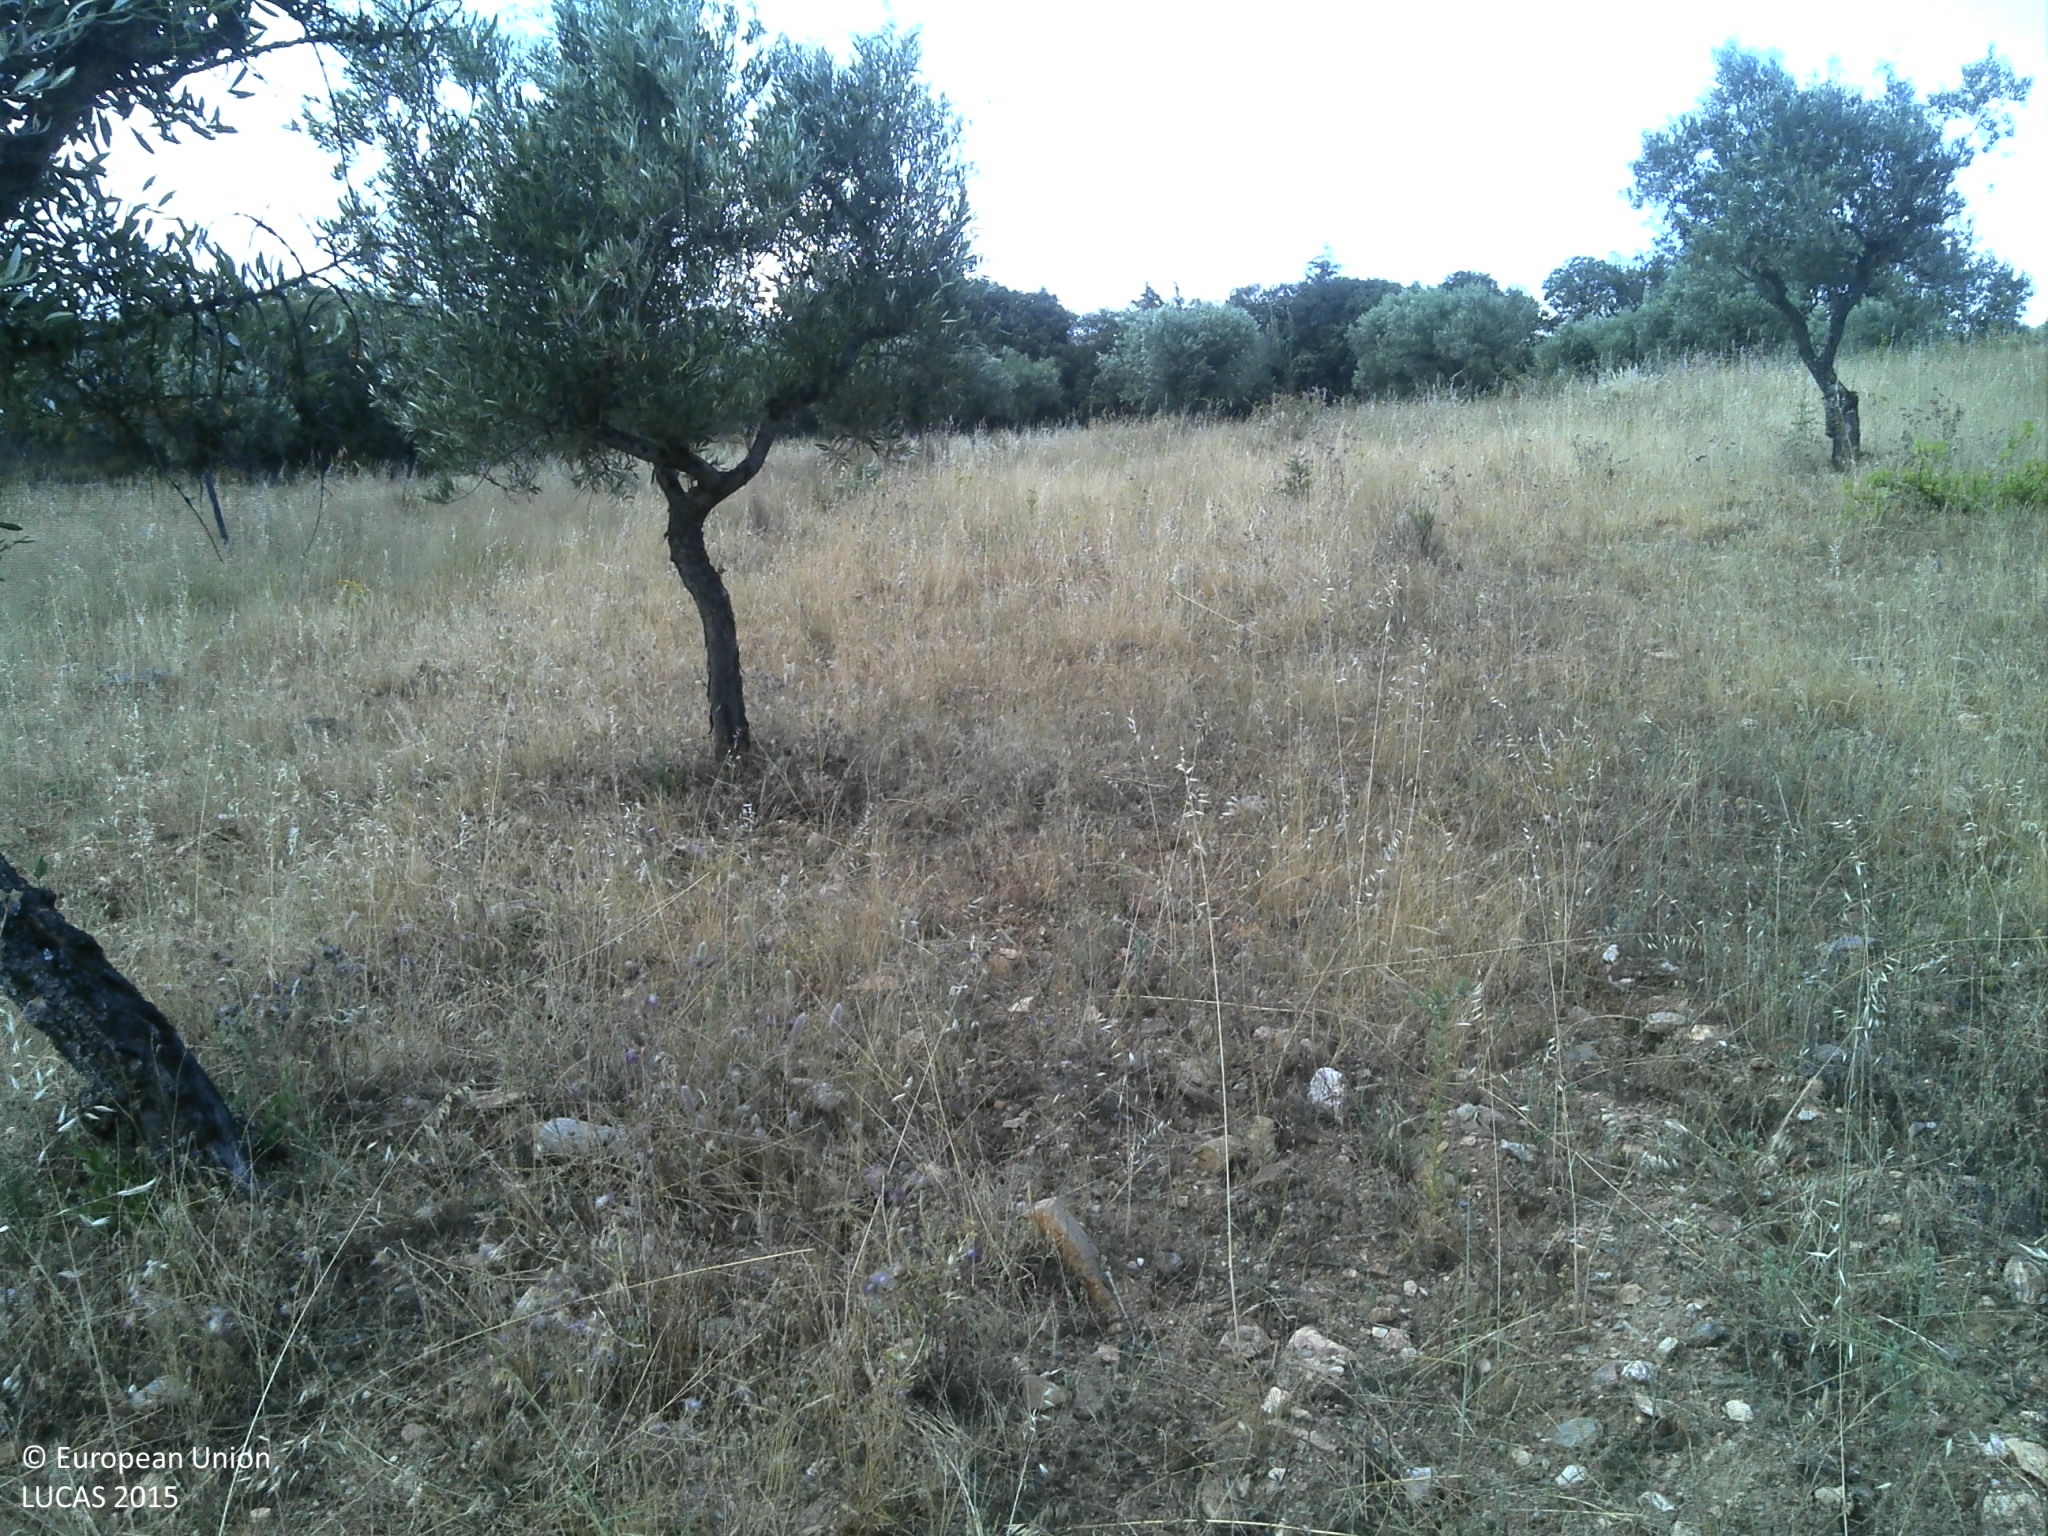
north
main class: Cropland
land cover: Olive groves
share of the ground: < 10 %
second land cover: Spontaneously vegetated surfaces
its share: 25 - 50 %
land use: Agriculture (excluding fallow land and kitchen gardens)
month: June
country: PT
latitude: 41.4800
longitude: -7.1106
